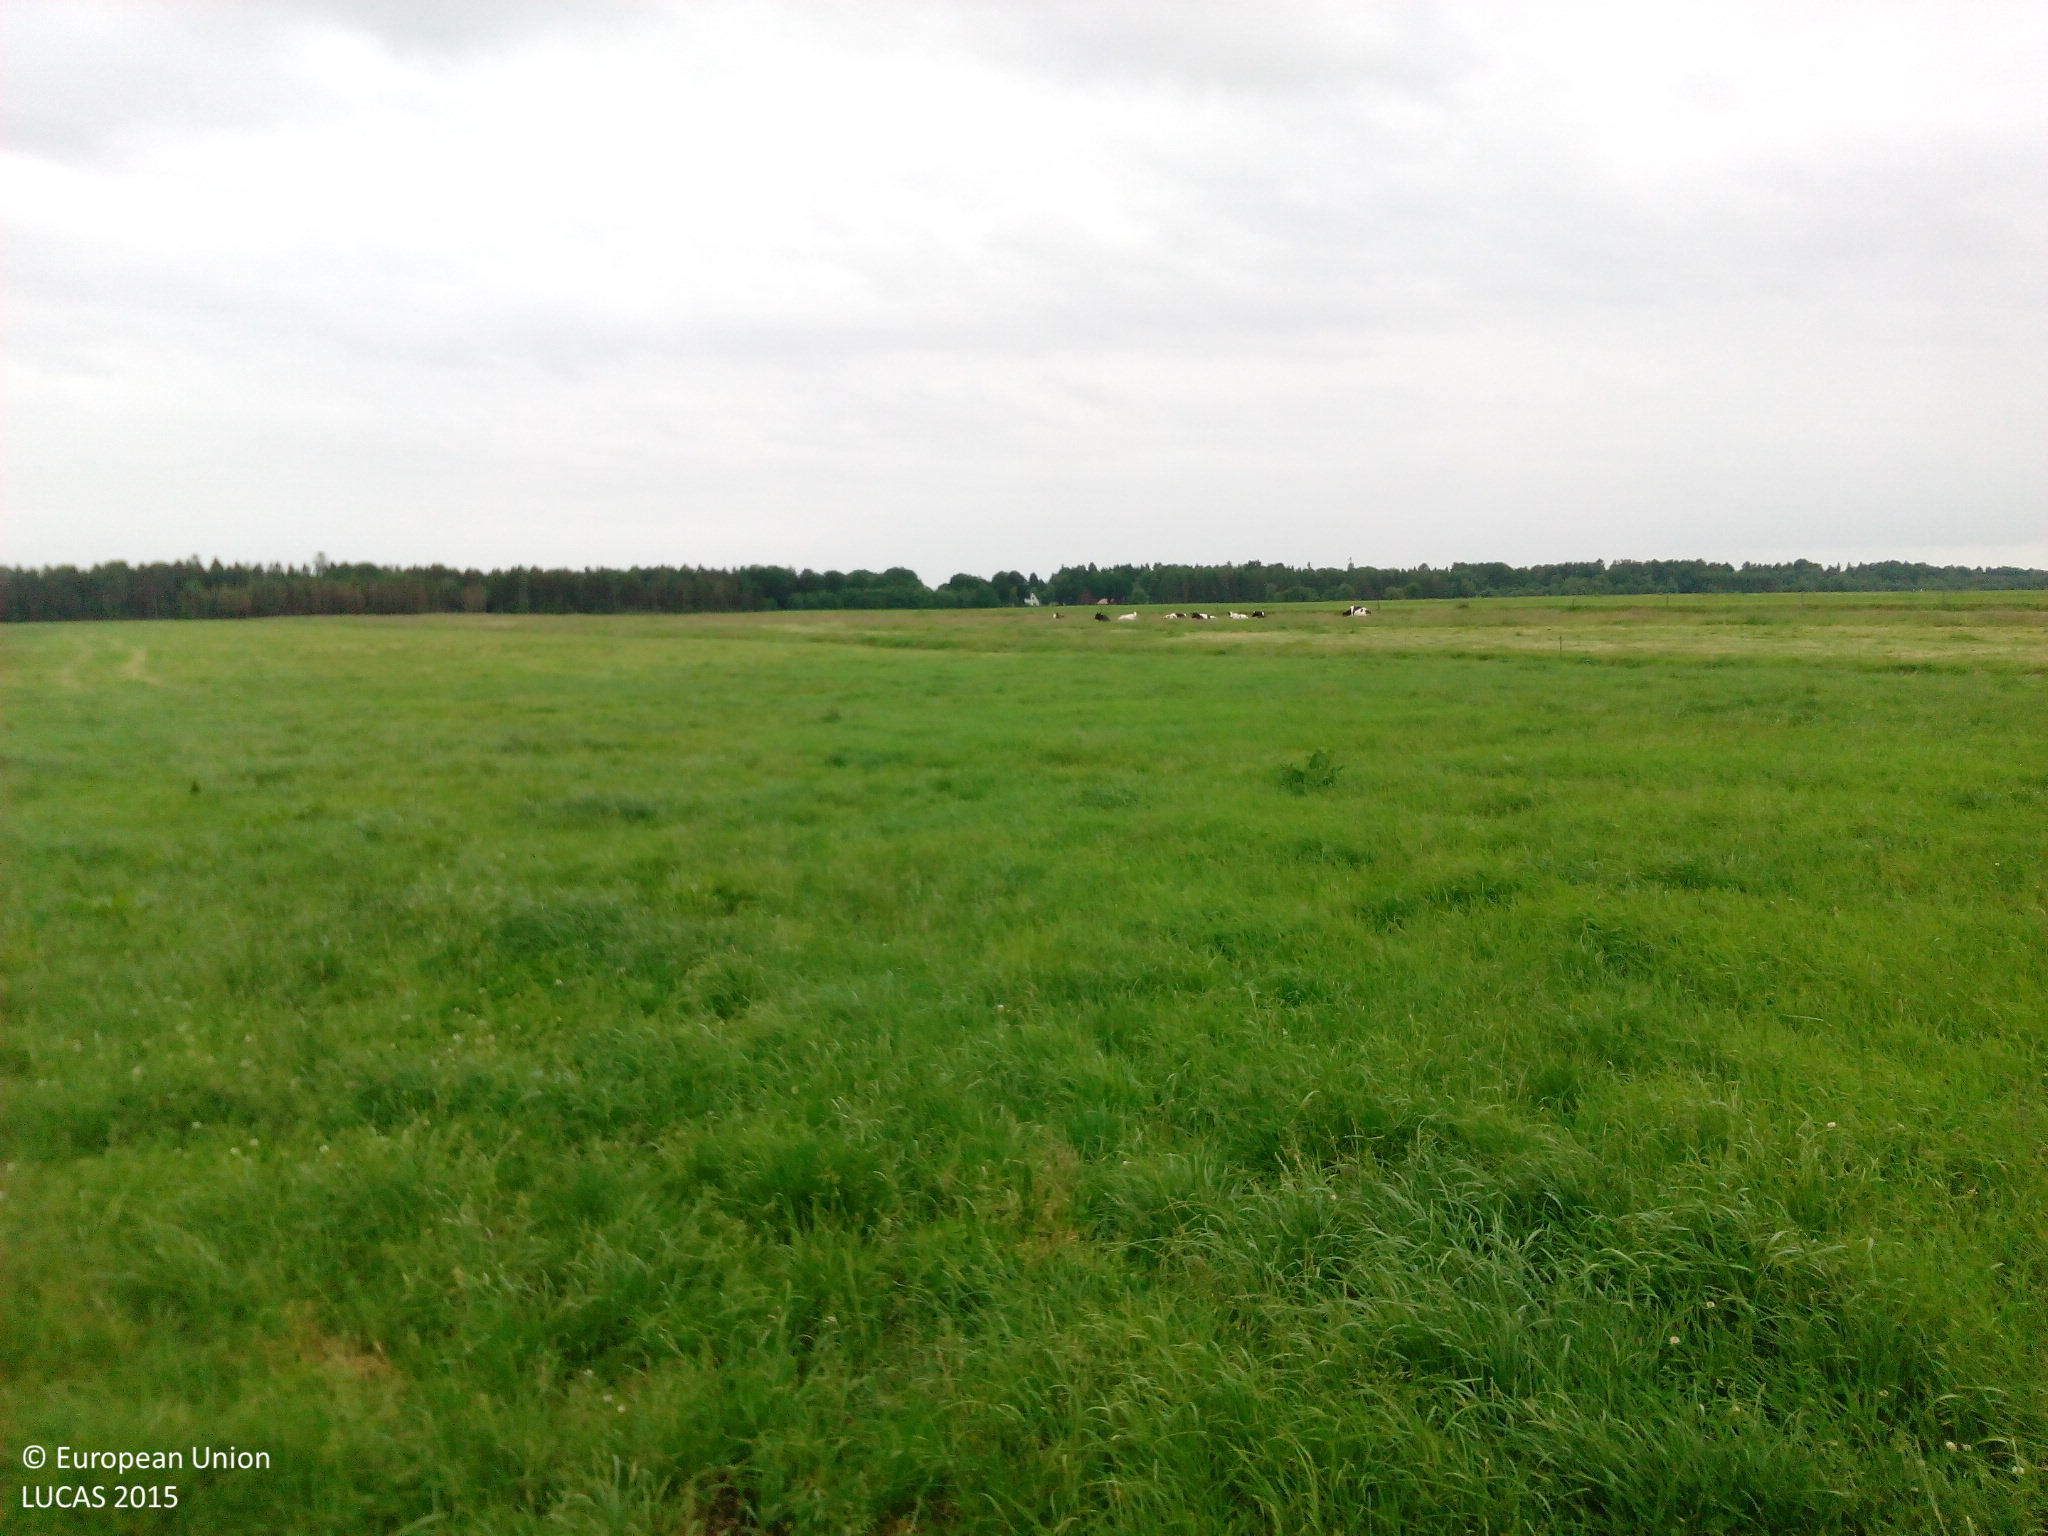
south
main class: Grassland
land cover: Grassland without tree/shrub cover
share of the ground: > 75 %
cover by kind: herbaceous plants 100 %
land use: Agriculture (excluding fallow land and kitchen gardens)
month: June
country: DE
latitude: 53.4344
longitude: 9.0822
